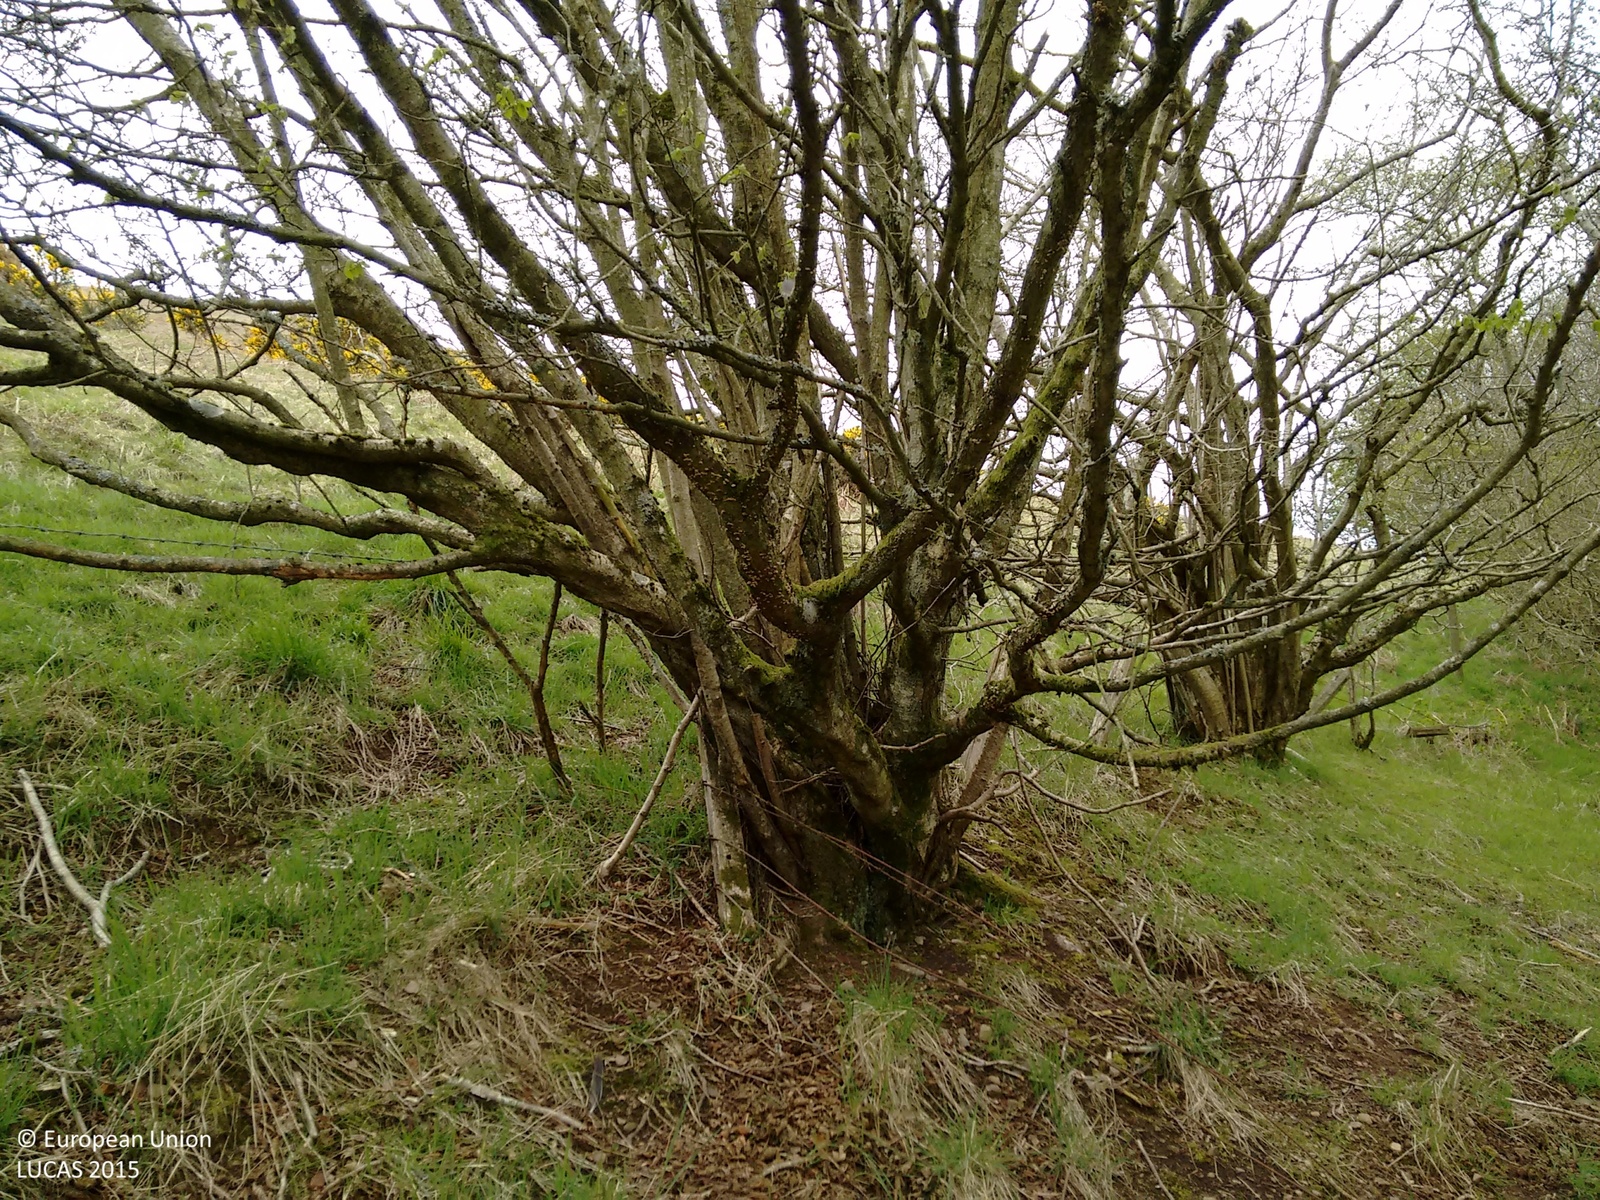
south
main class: Woodland
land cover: Broadleaved woodland
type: floodplain forest
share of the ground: > 75 %
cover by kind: broadleaved forest trees 95 %, herbaceous plants 5 %
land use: Semi-natural and natural areas not in use
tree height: > 5 m
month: May
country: GB
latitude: 55.7188
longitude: -2.6873
